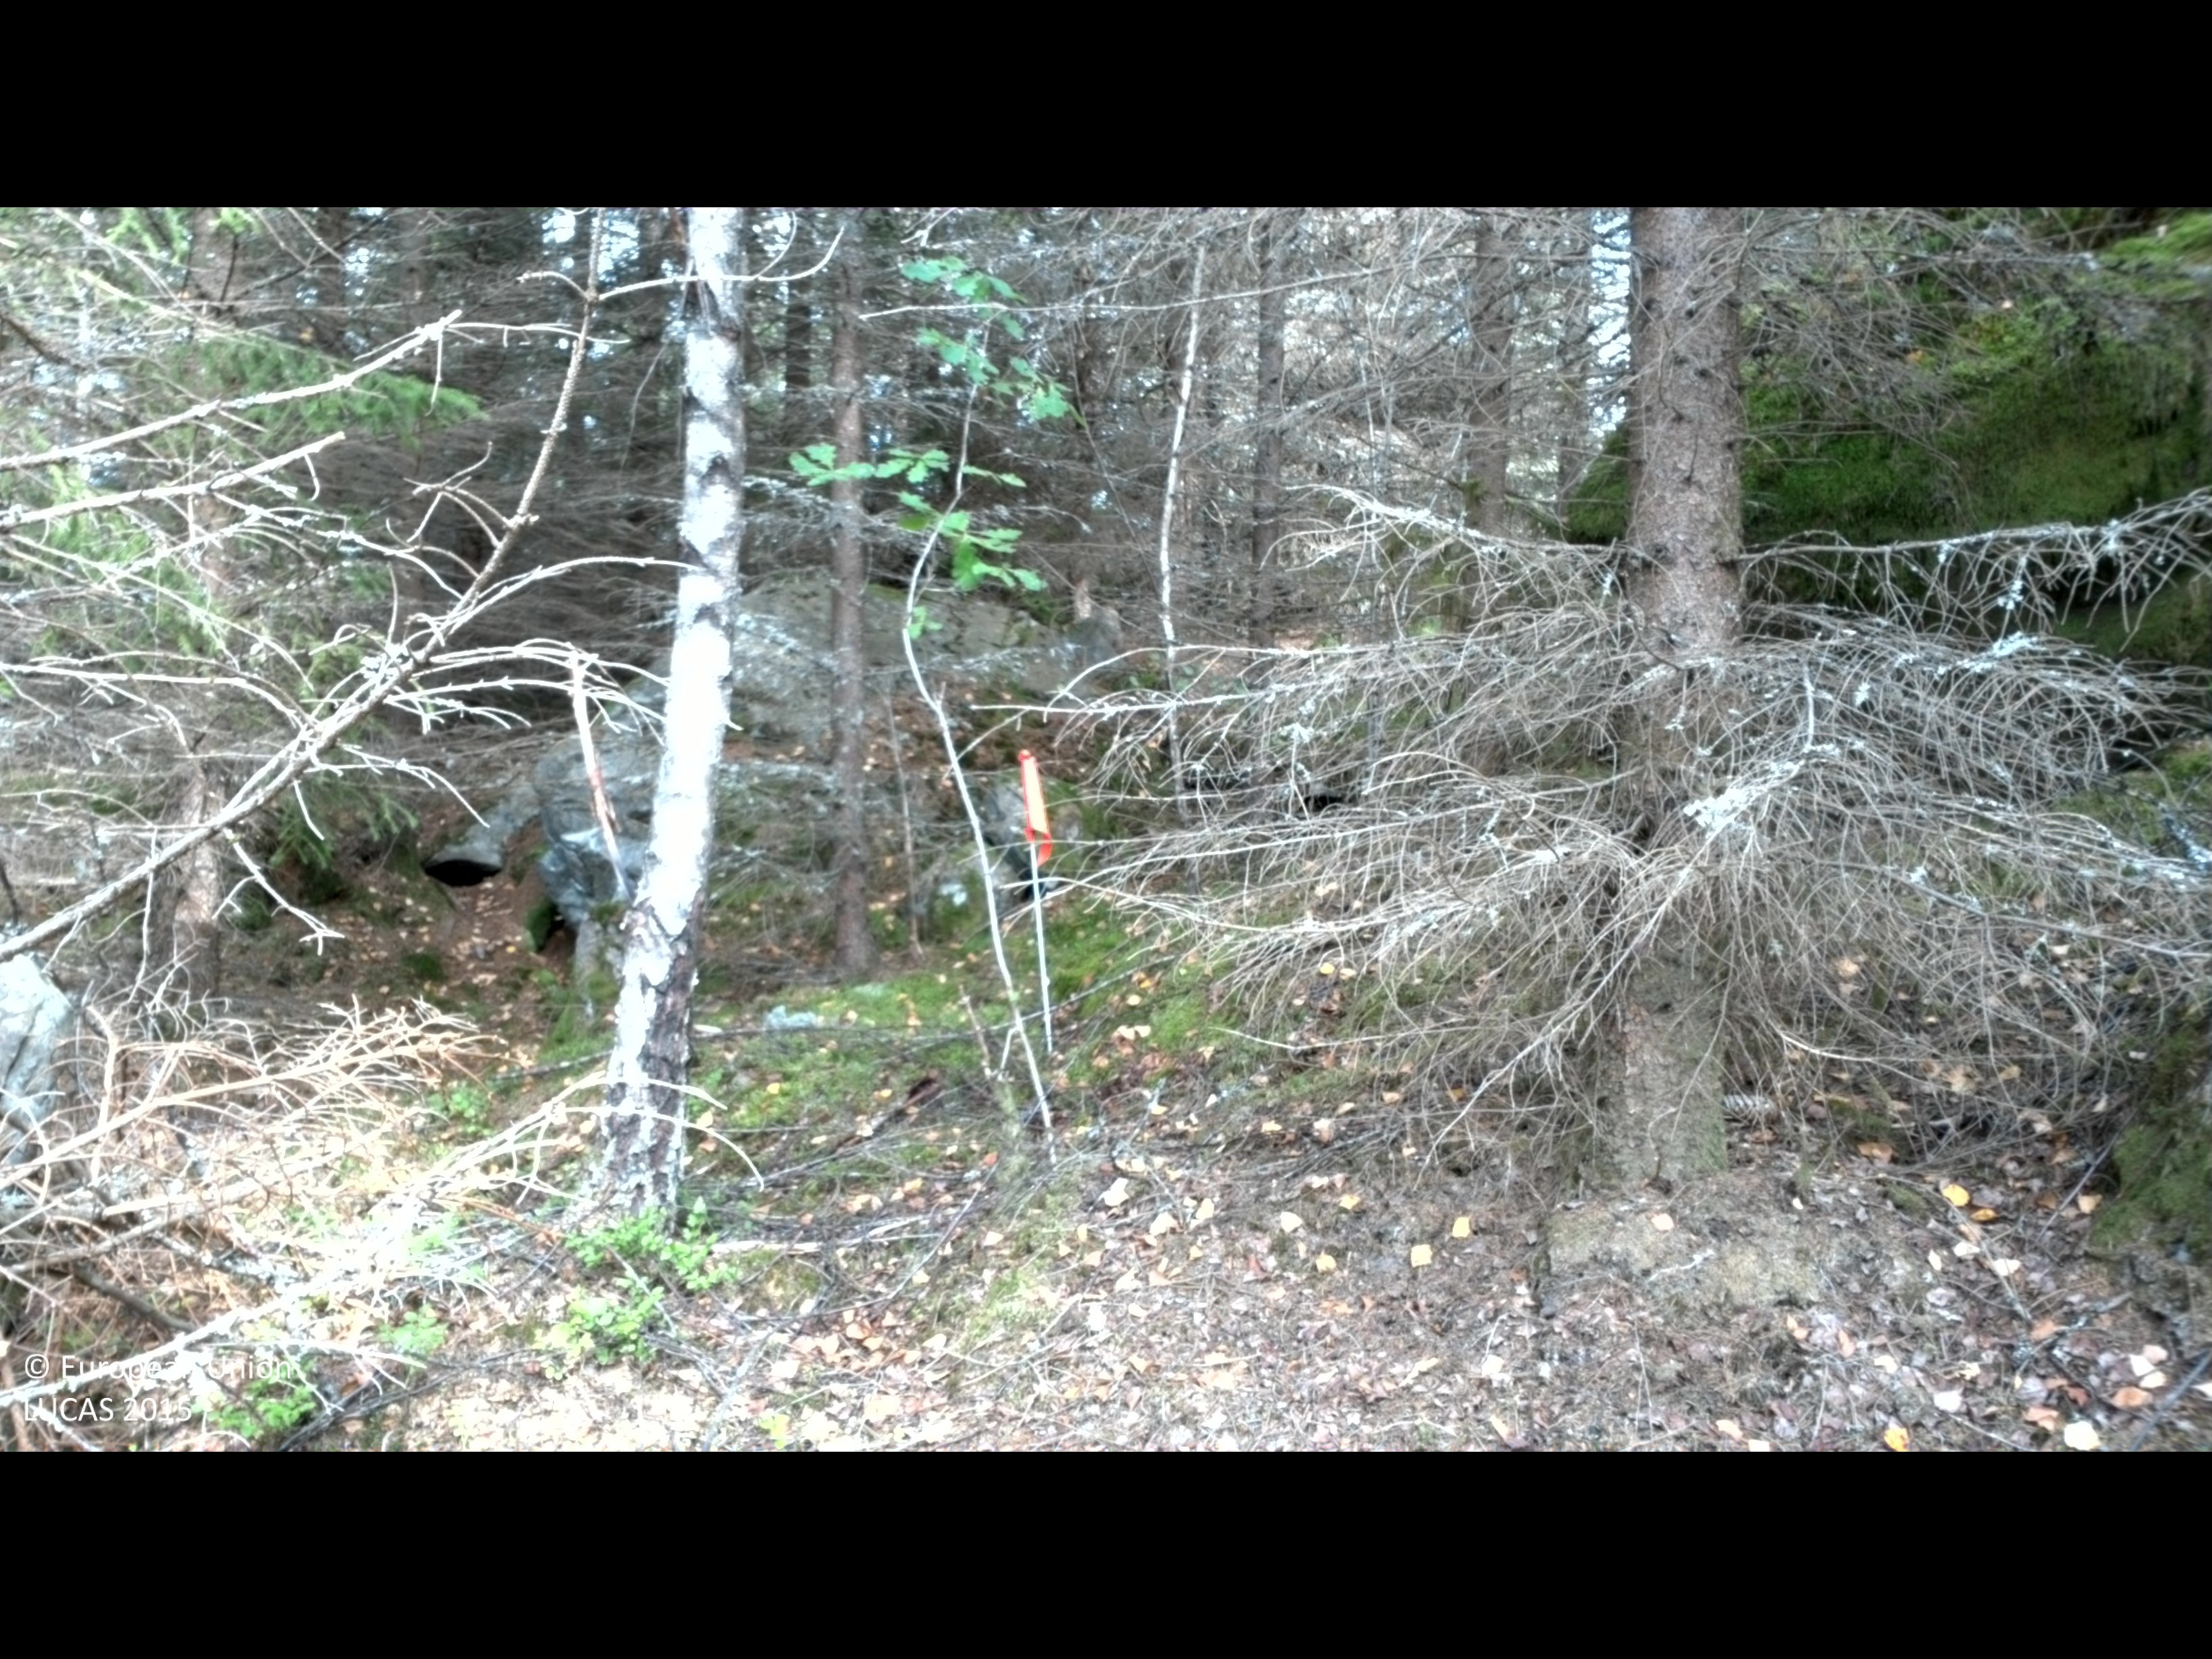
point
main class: Woodland
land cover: Spruce dominated coniferous woodland
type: boreal forest
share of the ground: > 75 %
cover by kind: coniferous forest trees 85 %, broadleaved forest trees 5 %, shrubs 5 %, lichens and mosses 5 %
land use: Forestry
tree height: > 5 m
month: August
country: SE
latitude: 56.3280
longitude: 14.4127
